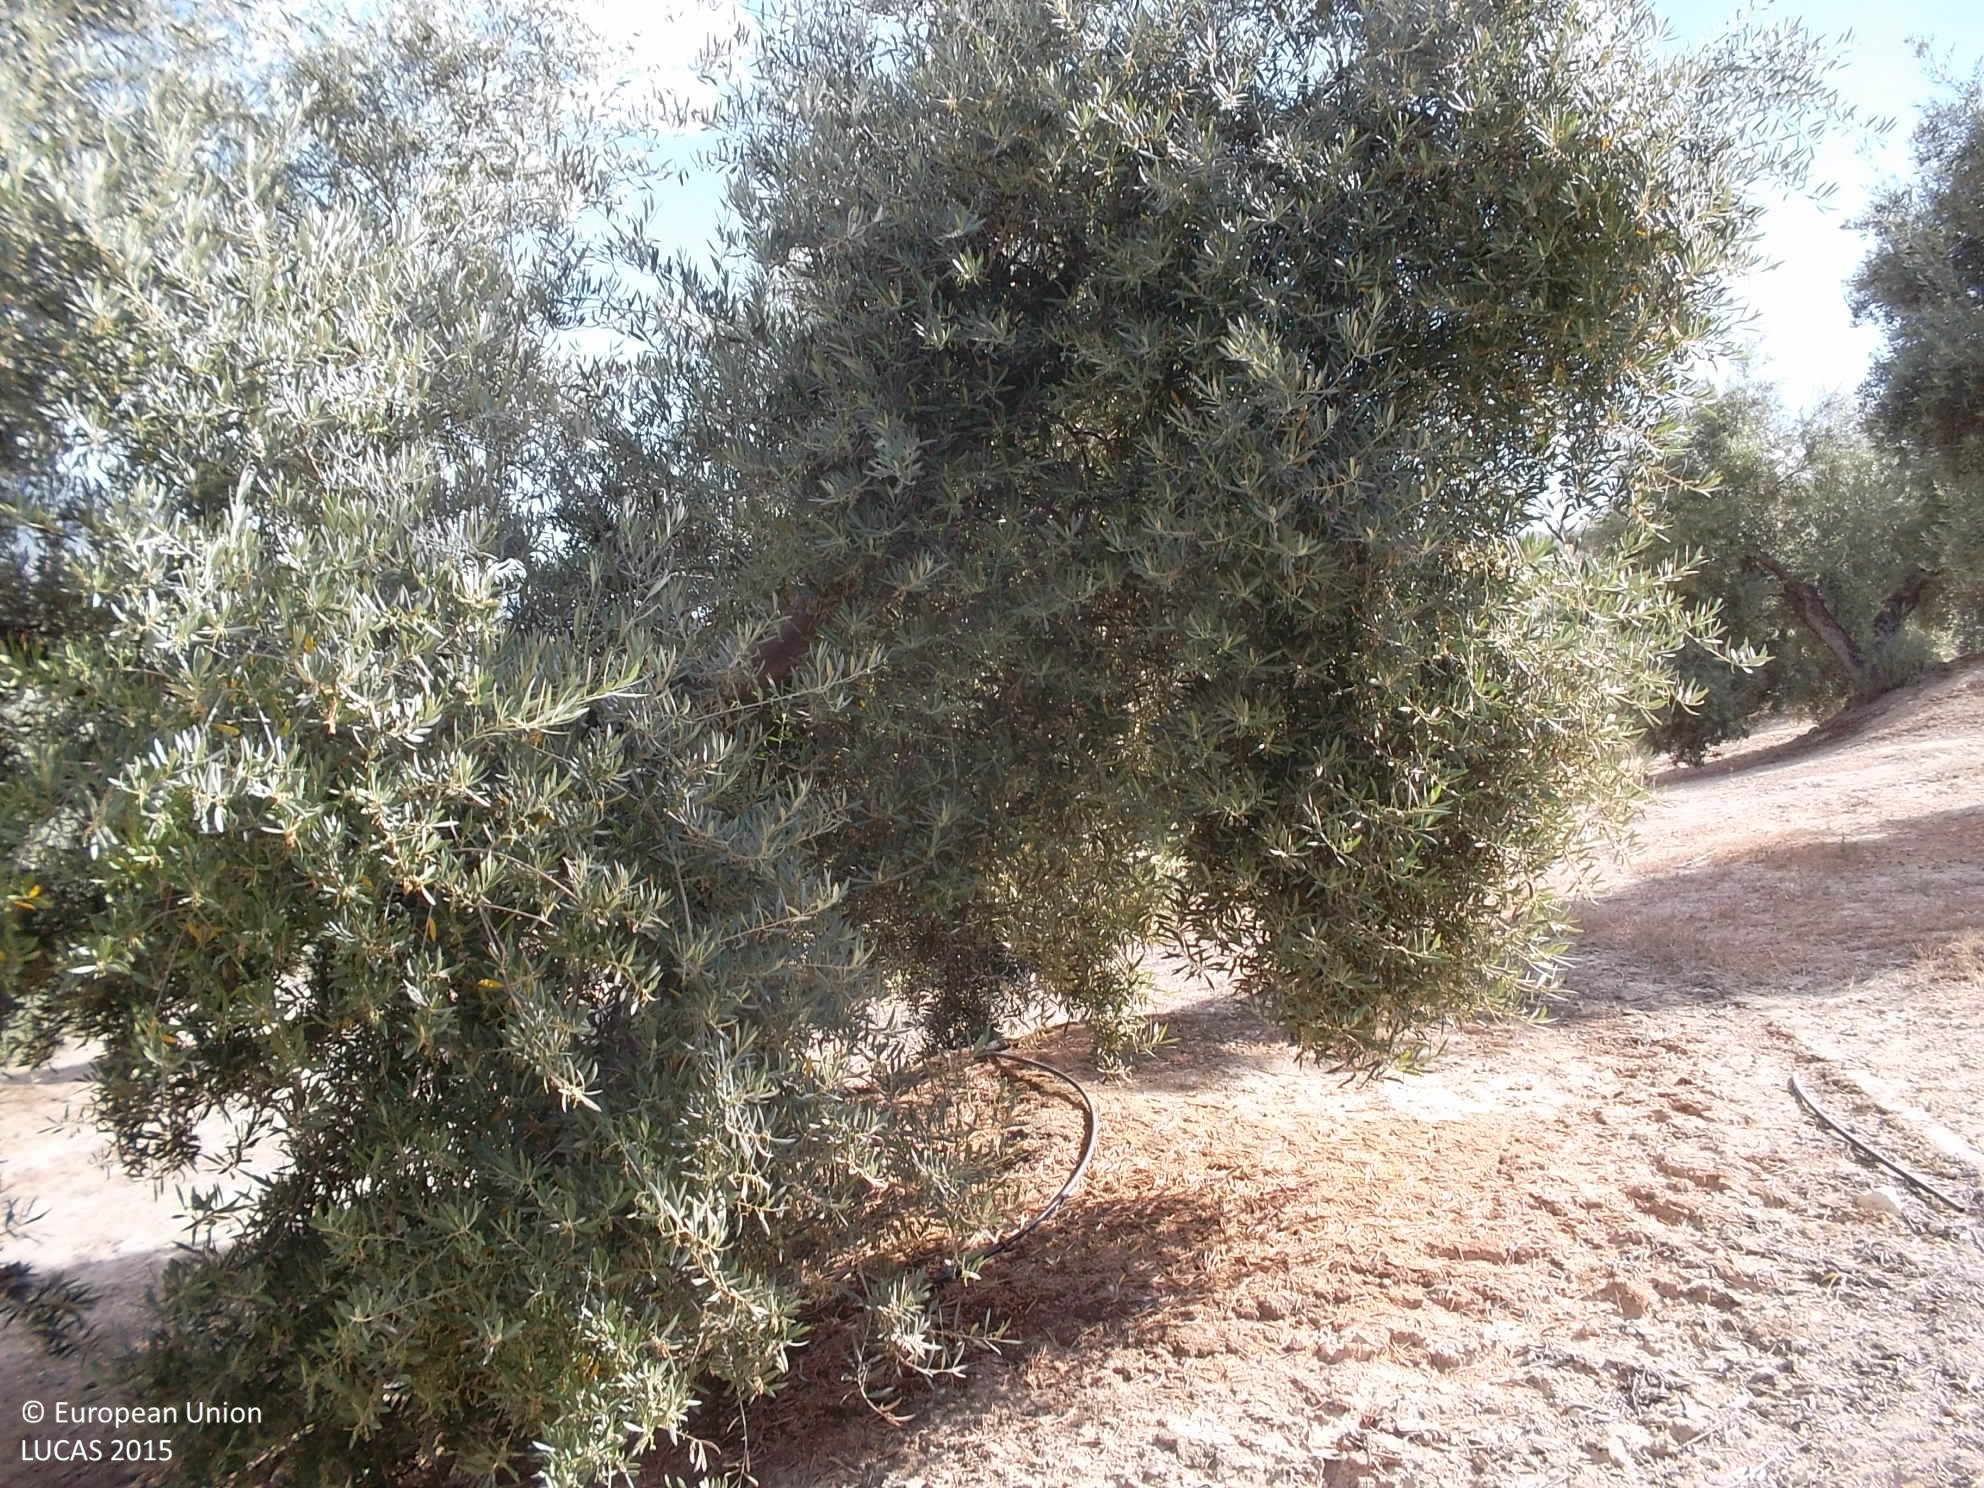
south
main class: Cropland
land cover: Olive groves
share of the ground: 50 - 75 %
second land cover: Other bare soil
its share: > 75 %
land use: Agriculture (excluding fallow land and kitchen gardens)
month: June
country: ES
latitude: 38.0045
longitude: -3.0138
